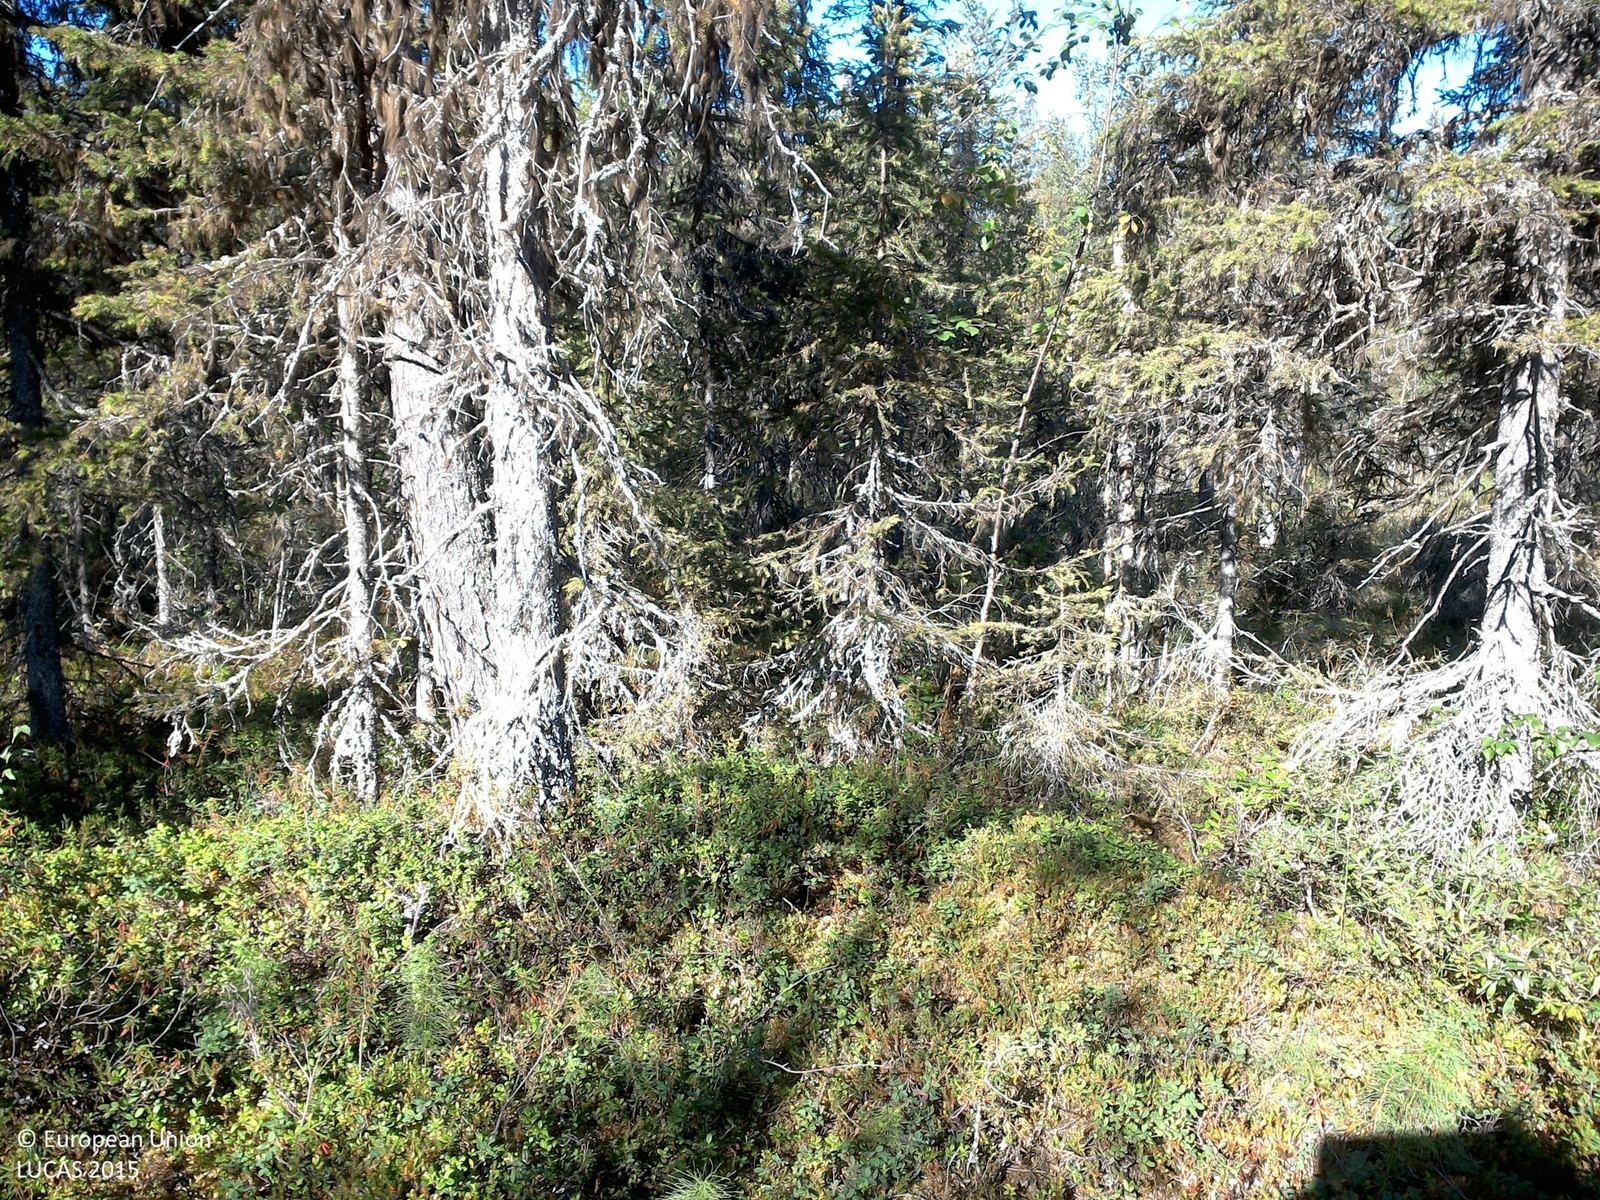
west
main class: Woodland
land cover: Spruce dominated mixed woodland
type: boreal forest
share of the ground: 25 - 50 %
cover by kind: shrubs 65 %, coniferous forest trees 20 %, broadleaved forest trees 10 %, lichens and mosses 5 %
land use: Forestry
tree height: > 5 m
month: August
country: SE
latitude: 67.1023
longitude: 21.3544
